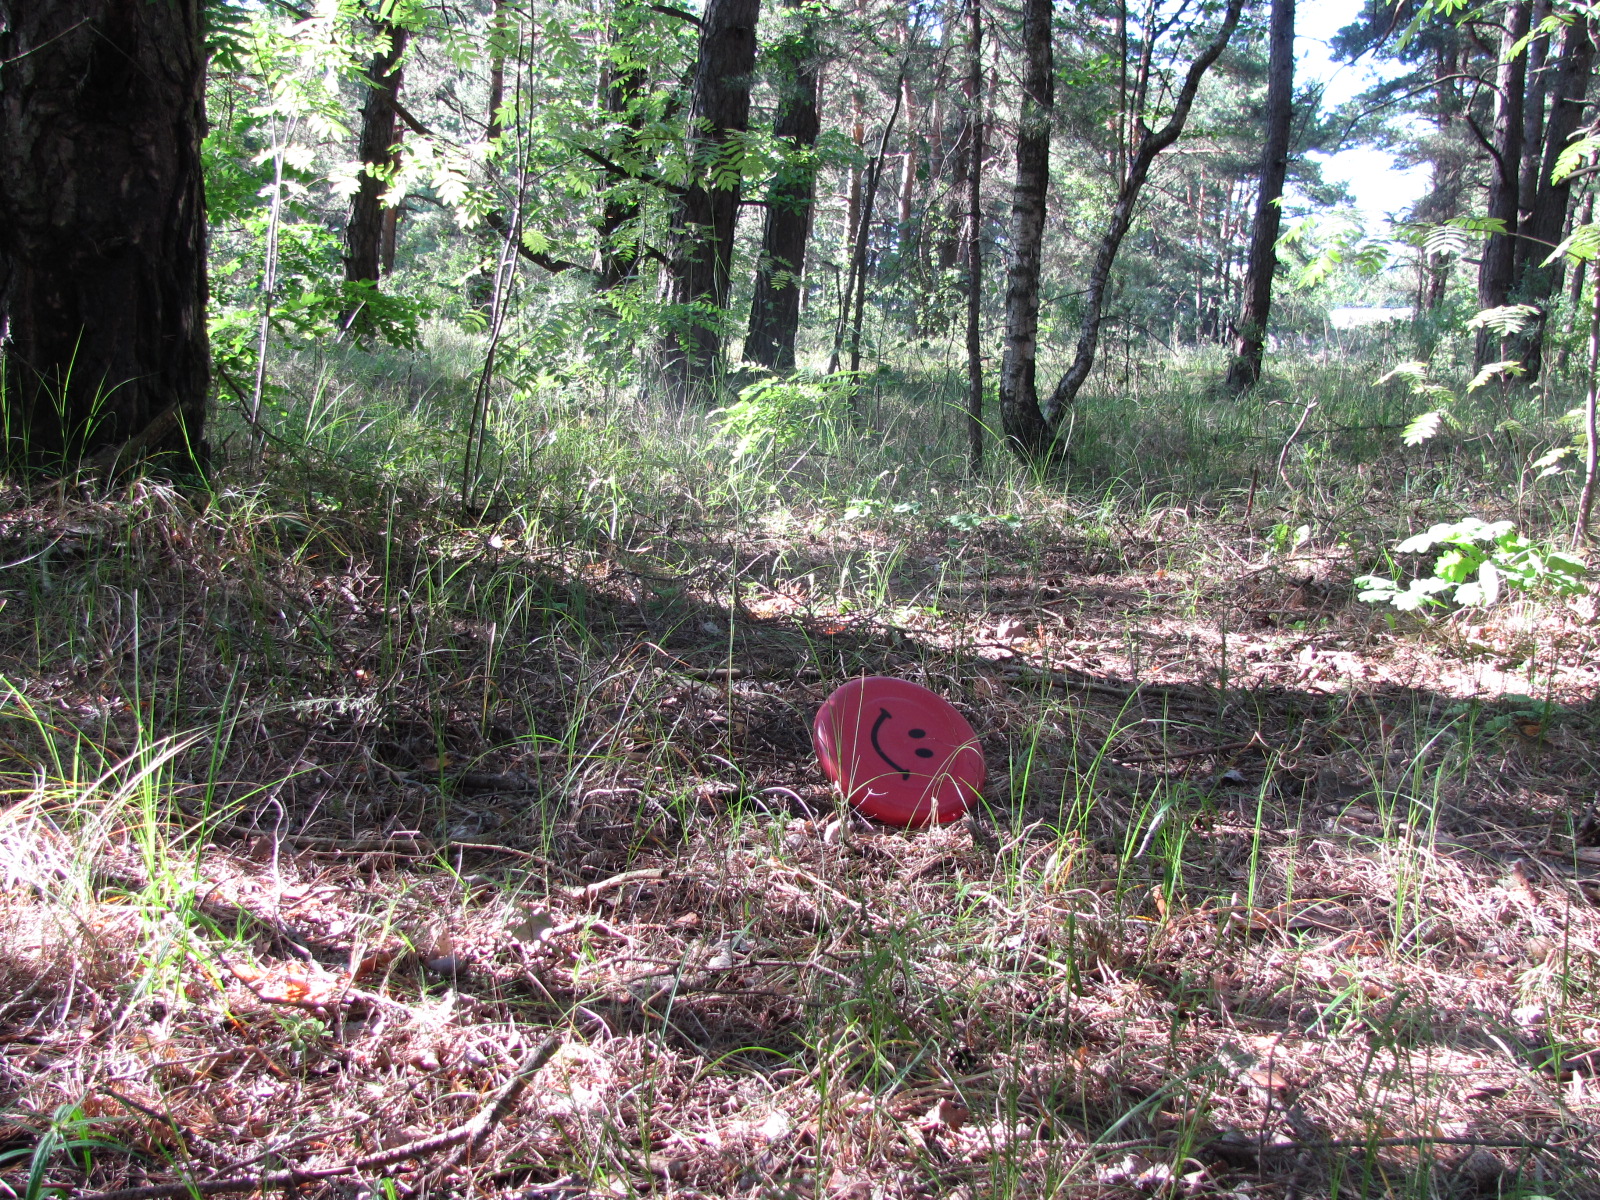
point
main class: Woodland
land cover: Pine dominated coniferous woodland
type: hemiboreal forest and nemoral coniferous forest and mixed broadleaved-coniferous forest
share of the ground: > 75 %
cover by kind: coniferous forest trees 80 %, herbaceous plants 10 %, lichens and mosses 10 %
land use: Forestry
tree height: > 5 m
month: June
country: LV
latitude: 57.0204
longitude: 24.0350
